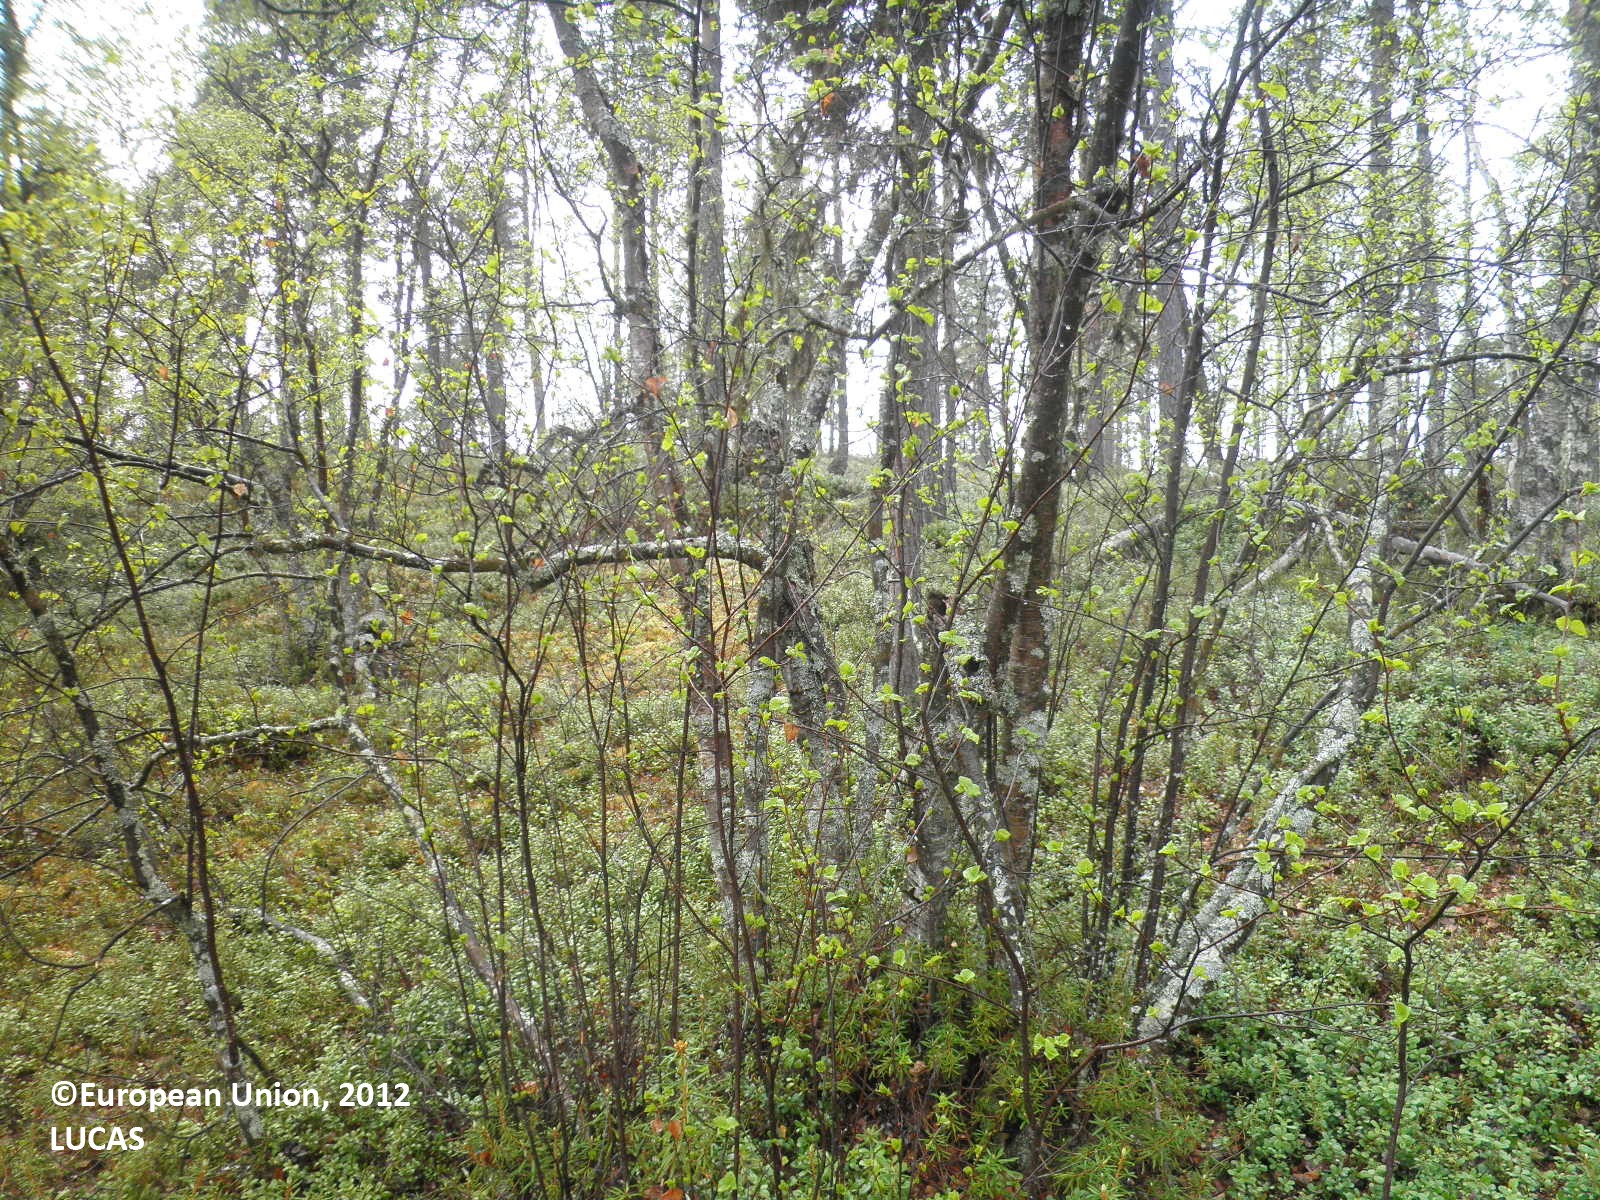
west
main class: Woodland
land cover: Pine dominated mixed woodland
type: boreal forest
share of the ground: 50 - 75 %
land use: Forestry
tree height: > 5 m
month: June
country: FI
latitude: 69.0504
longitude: 27.1265
